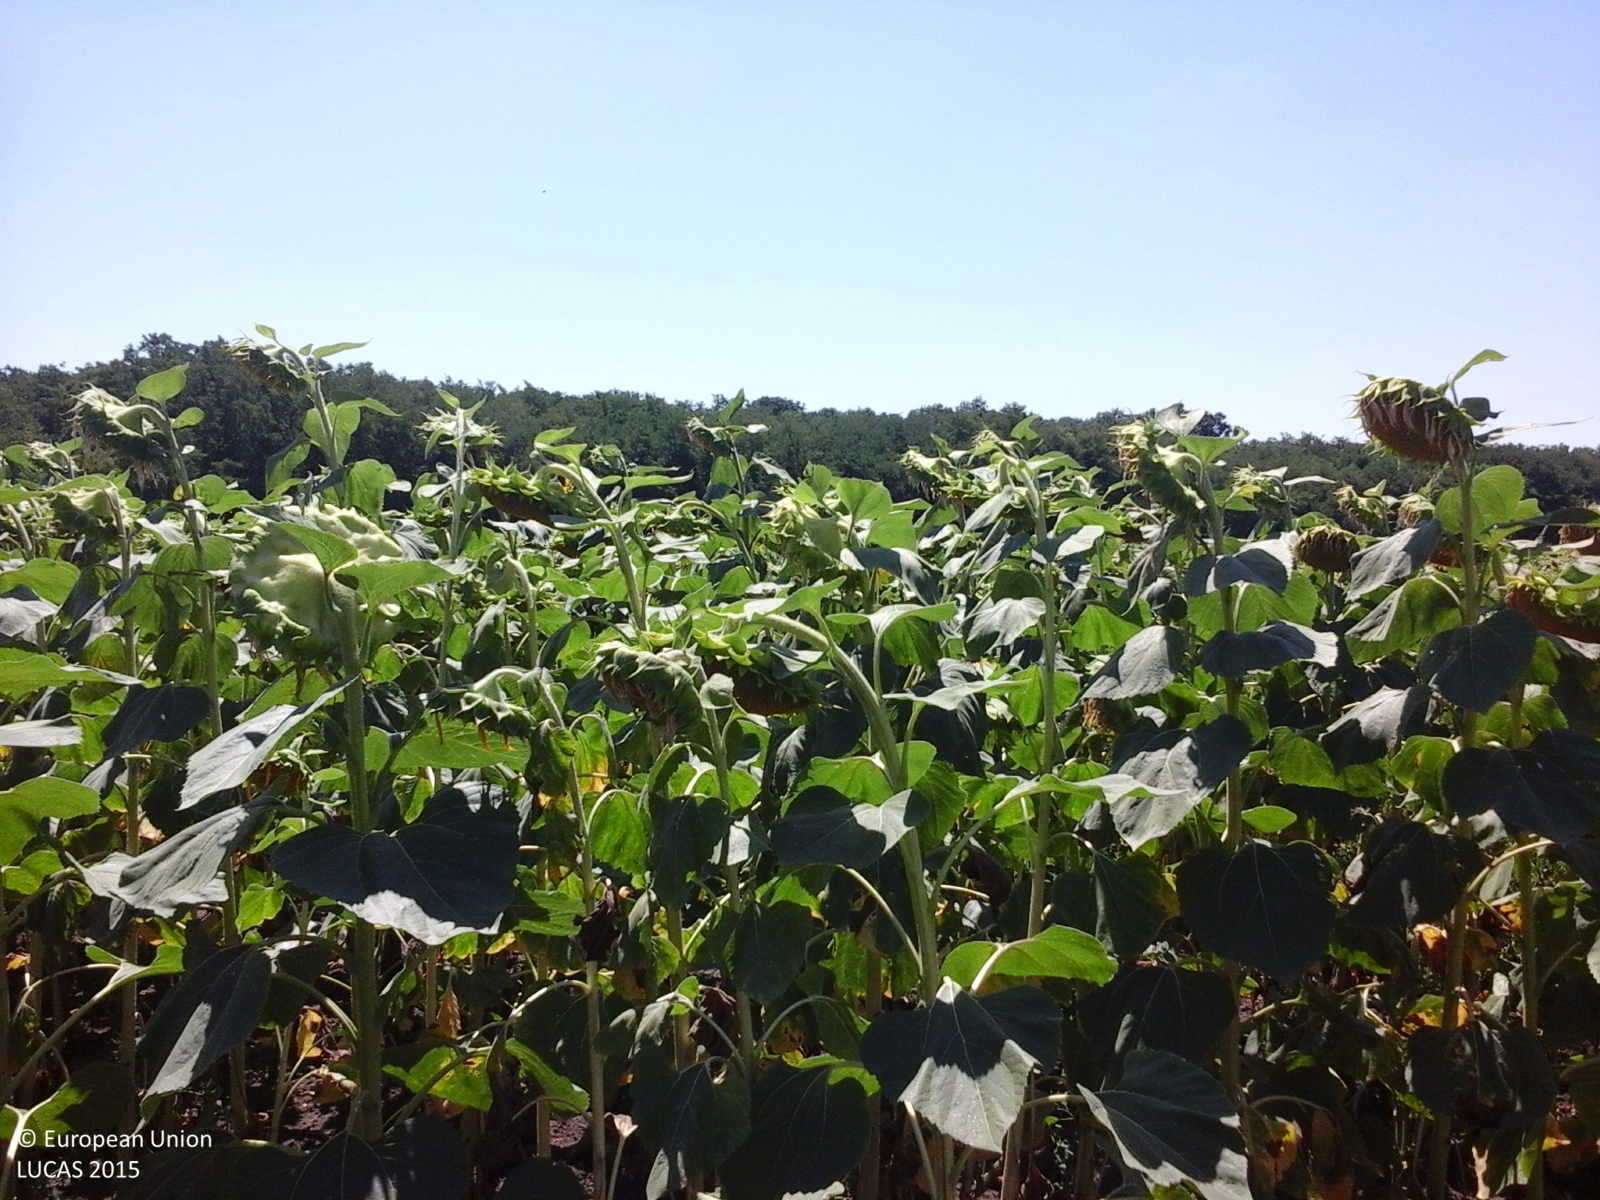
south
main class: Cropland
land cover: Sunflower
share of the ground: > 75 %
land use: Agriculture (excluding fallow land and kitchen gardens)
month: July
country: RO
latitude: 44.2657
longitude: 26.7427
